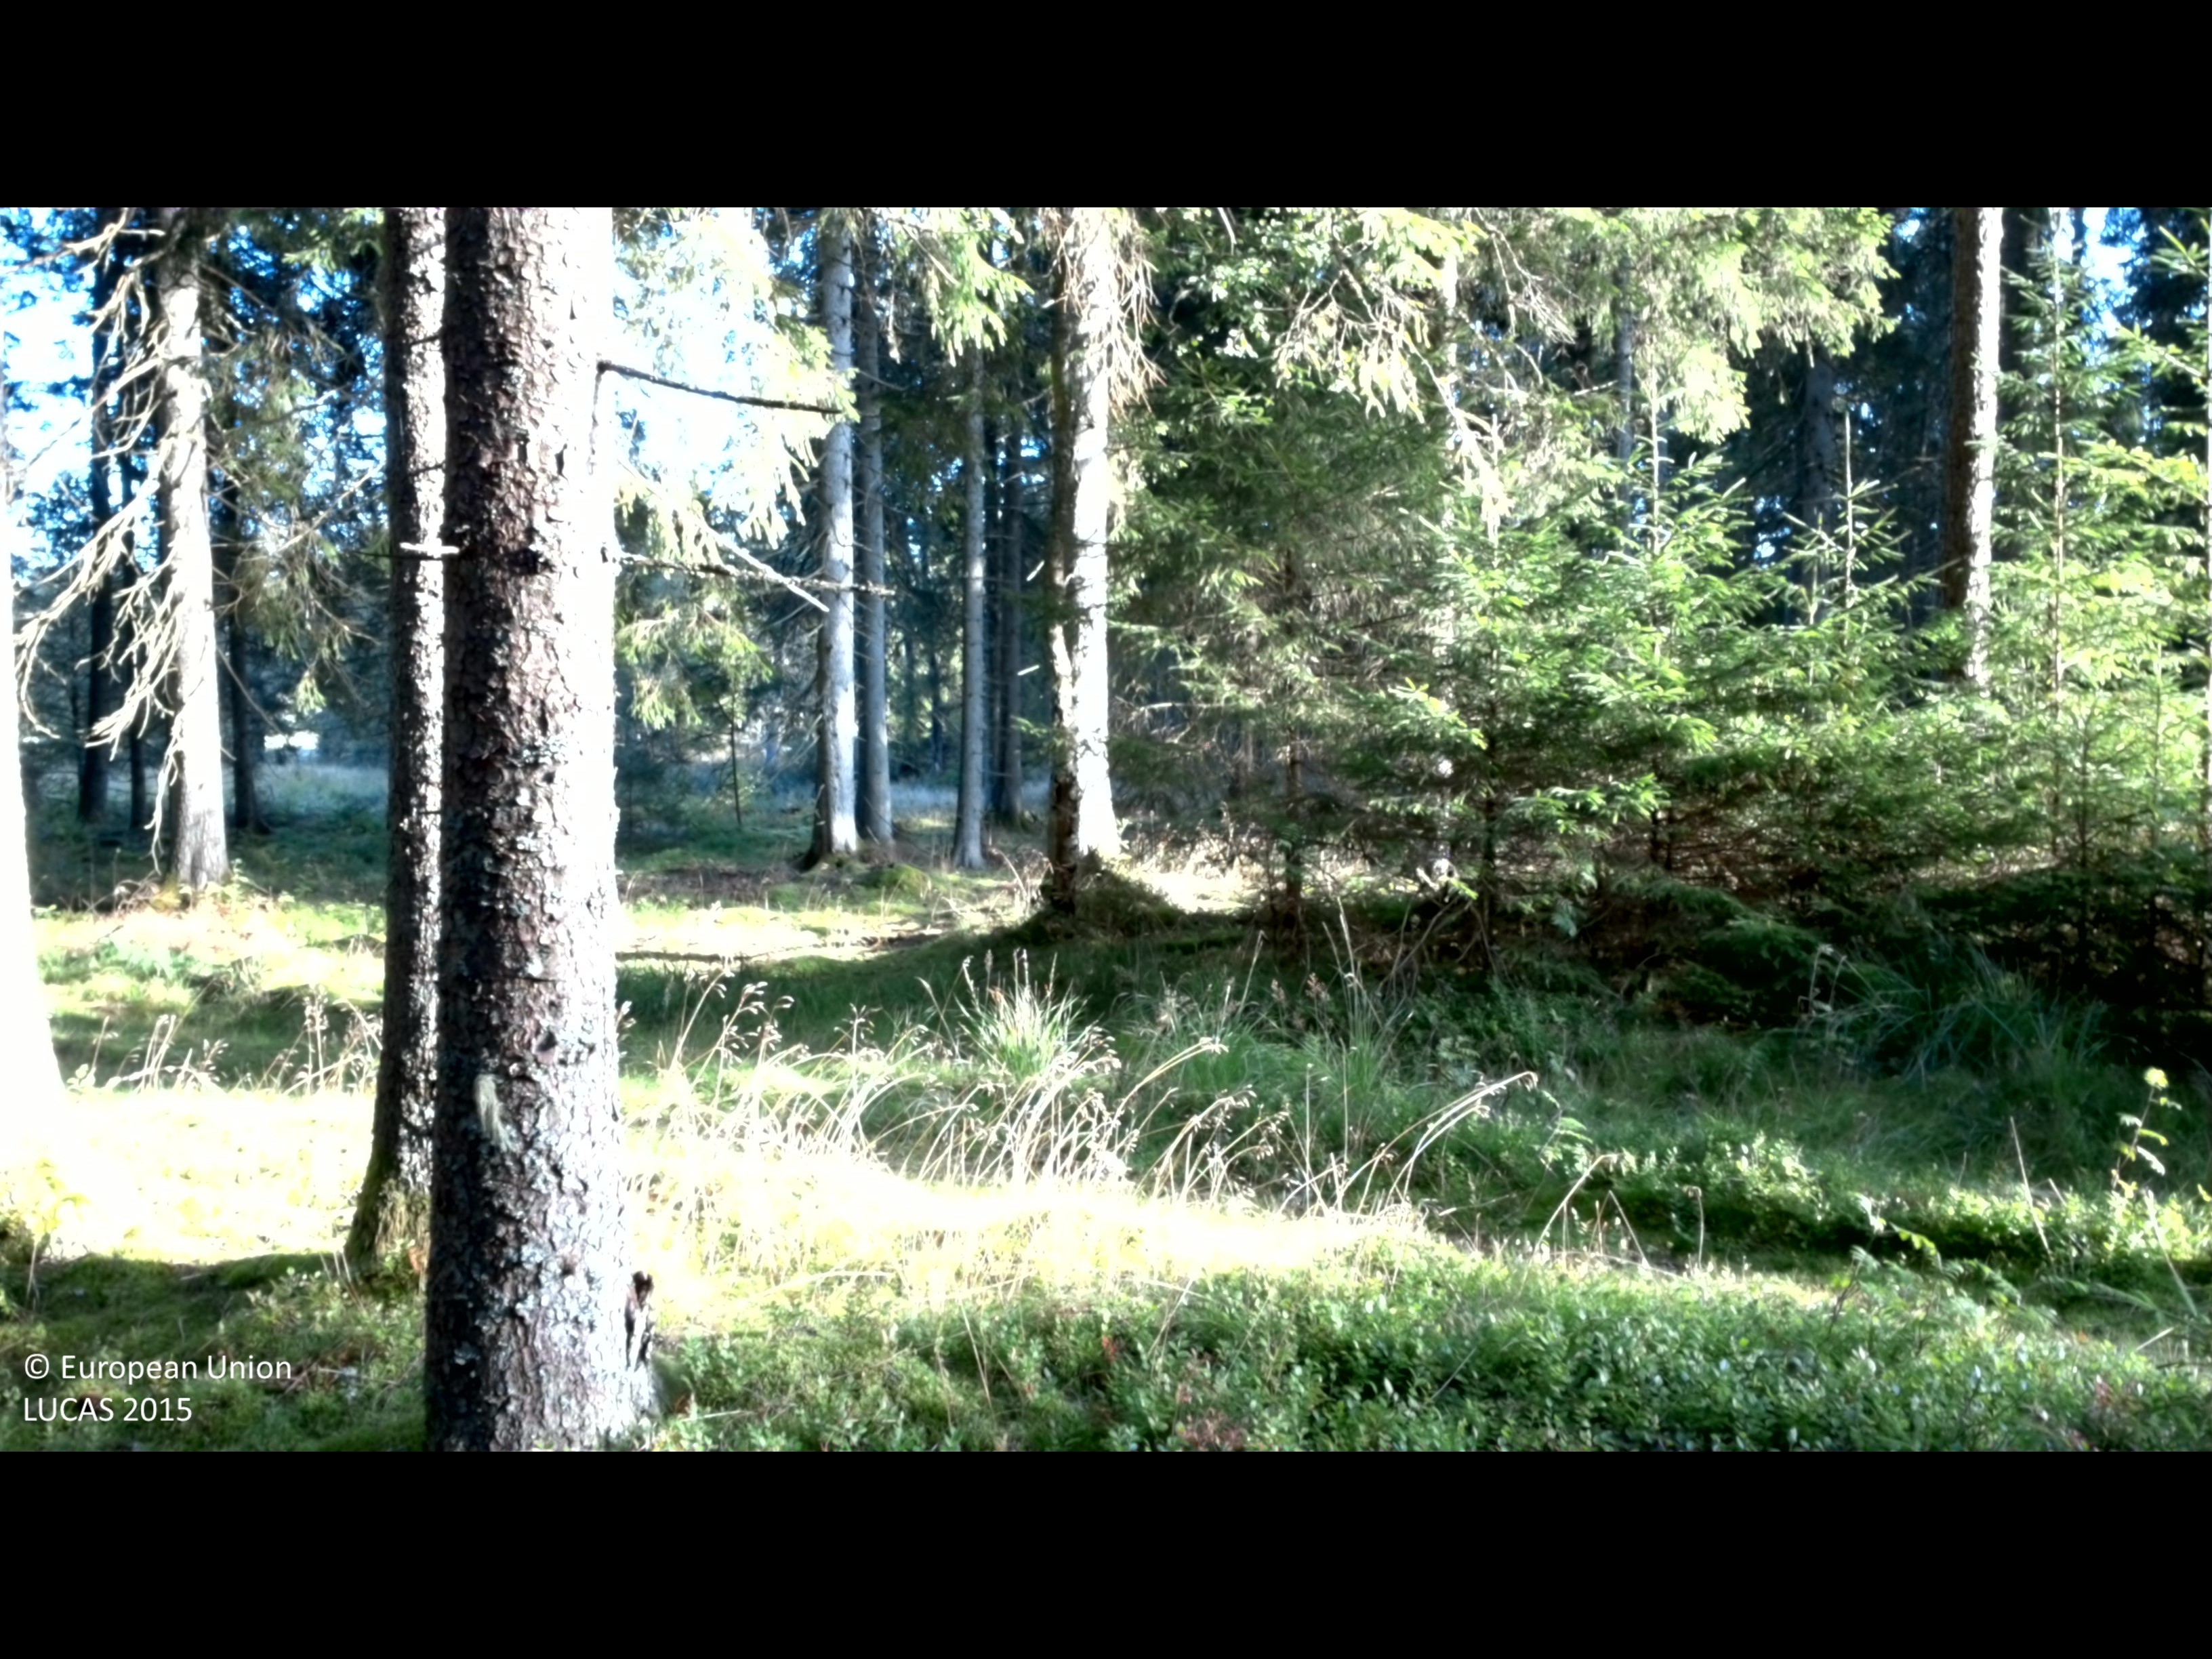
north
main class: Woodland
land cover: Spruce dominated coniferous woodland
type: boreal forest
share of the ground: 50 - 75 %
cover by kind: coniferous forest trees 60 %, shrubs 15 %, lichens and mosses 15 %, herbaceous plants 10 %
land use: Forestry
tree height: > 5 m
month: September
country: SE
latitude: 57.1020
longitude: 13.1823
